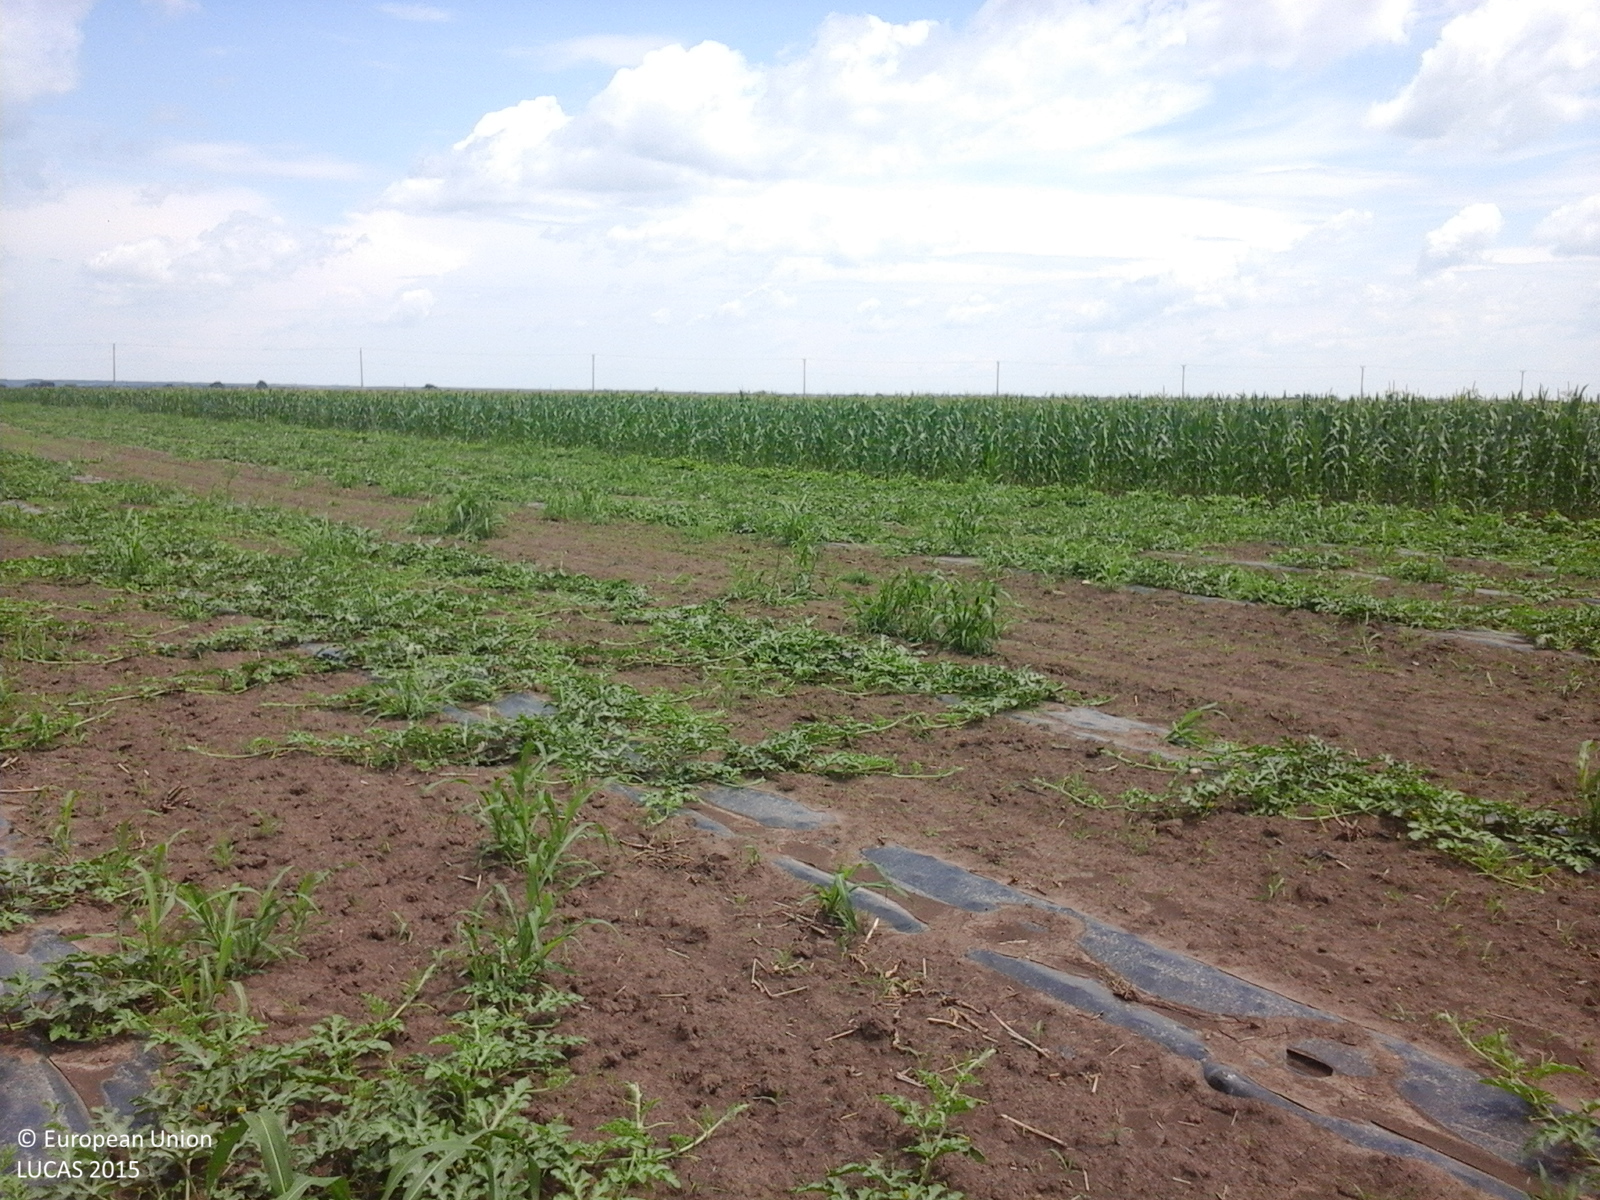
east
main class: Cropland
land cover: Other fresh vegetables
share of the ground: 50 - 75 %
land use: Agriculture (excluding fallow land and kitchen gardens)
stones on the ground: < 10 %
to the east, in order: Other fresh vegetables; Maize; Rye; Maize; Grass margins; Other fresh vegetables; Maize
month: July
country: RO
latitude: 44.0530
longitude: 24.5343
